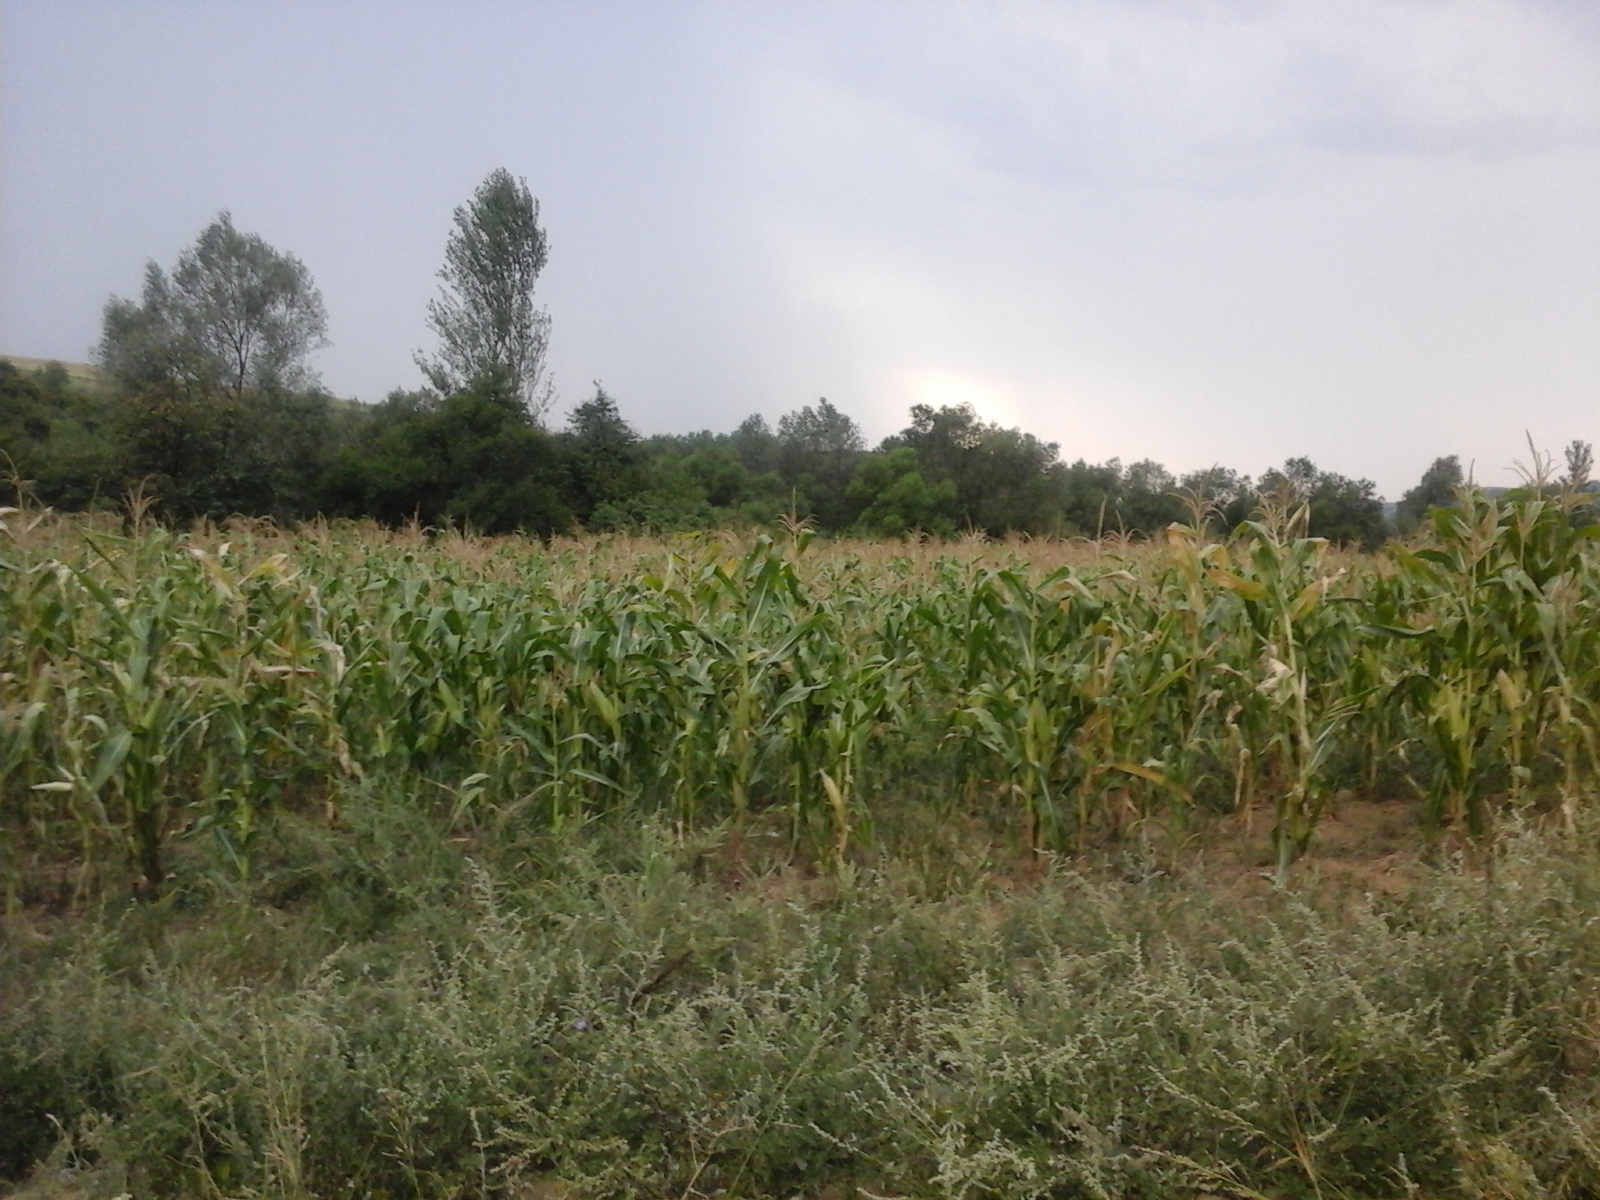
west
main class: Grassland
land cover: Spontaneously vegetated surfaces
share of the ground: > 75 %
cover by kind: herbaceous plants 100 %
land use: Agriculture (excluding fallow land and kitchen gardens)
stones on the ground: < 10 %
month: August
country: RO
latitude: 44.6369
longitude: 23.3263
